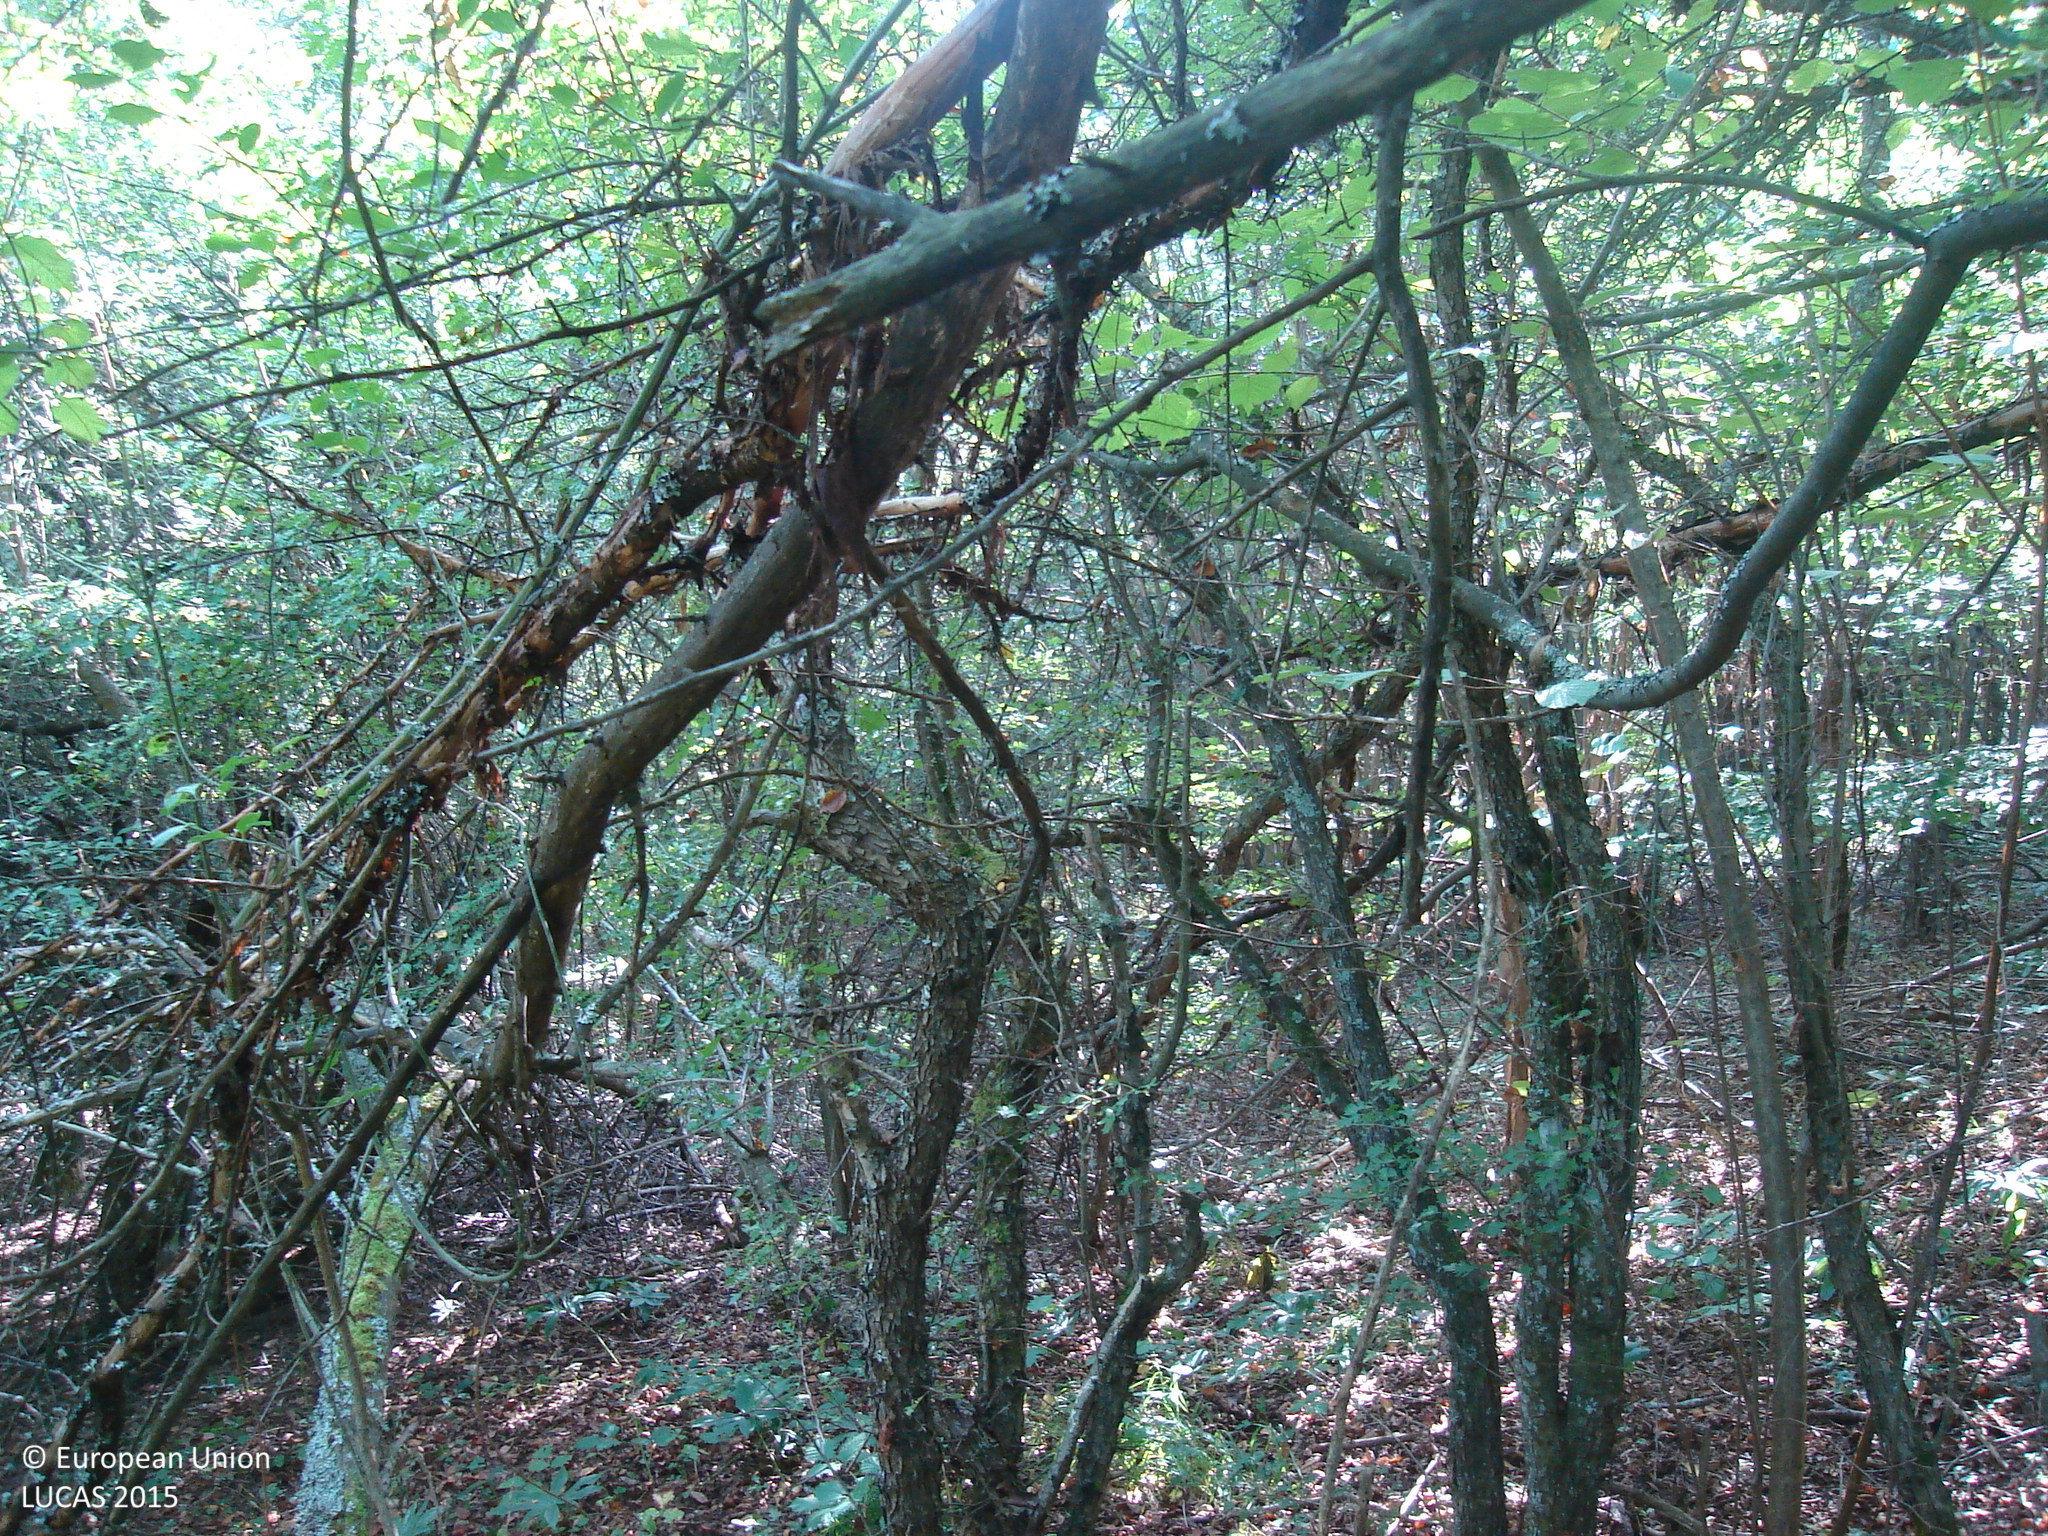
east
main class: Woodland
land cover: Broadleaved woodland
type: thermophilous deciduous forest
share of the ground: > 75 %
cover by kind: broadleaved forest trees 95 %, herbaceous plants 5 %
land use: Forestry
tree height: > 5 m
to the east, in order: Broadleaved woodland; Spontaneously vegetated surfaces; Tracks; Broadleaved woodland; Shrubland without tree cover; Abandoned hedges; Ditches and canals; Shrubland without tree cover; Spontaneously vegetated surfaces; Broadleaved woodland; Ditches and canals; Broadleaved woodland
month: September
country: BG
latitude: 42.9840
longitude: 23.1194
